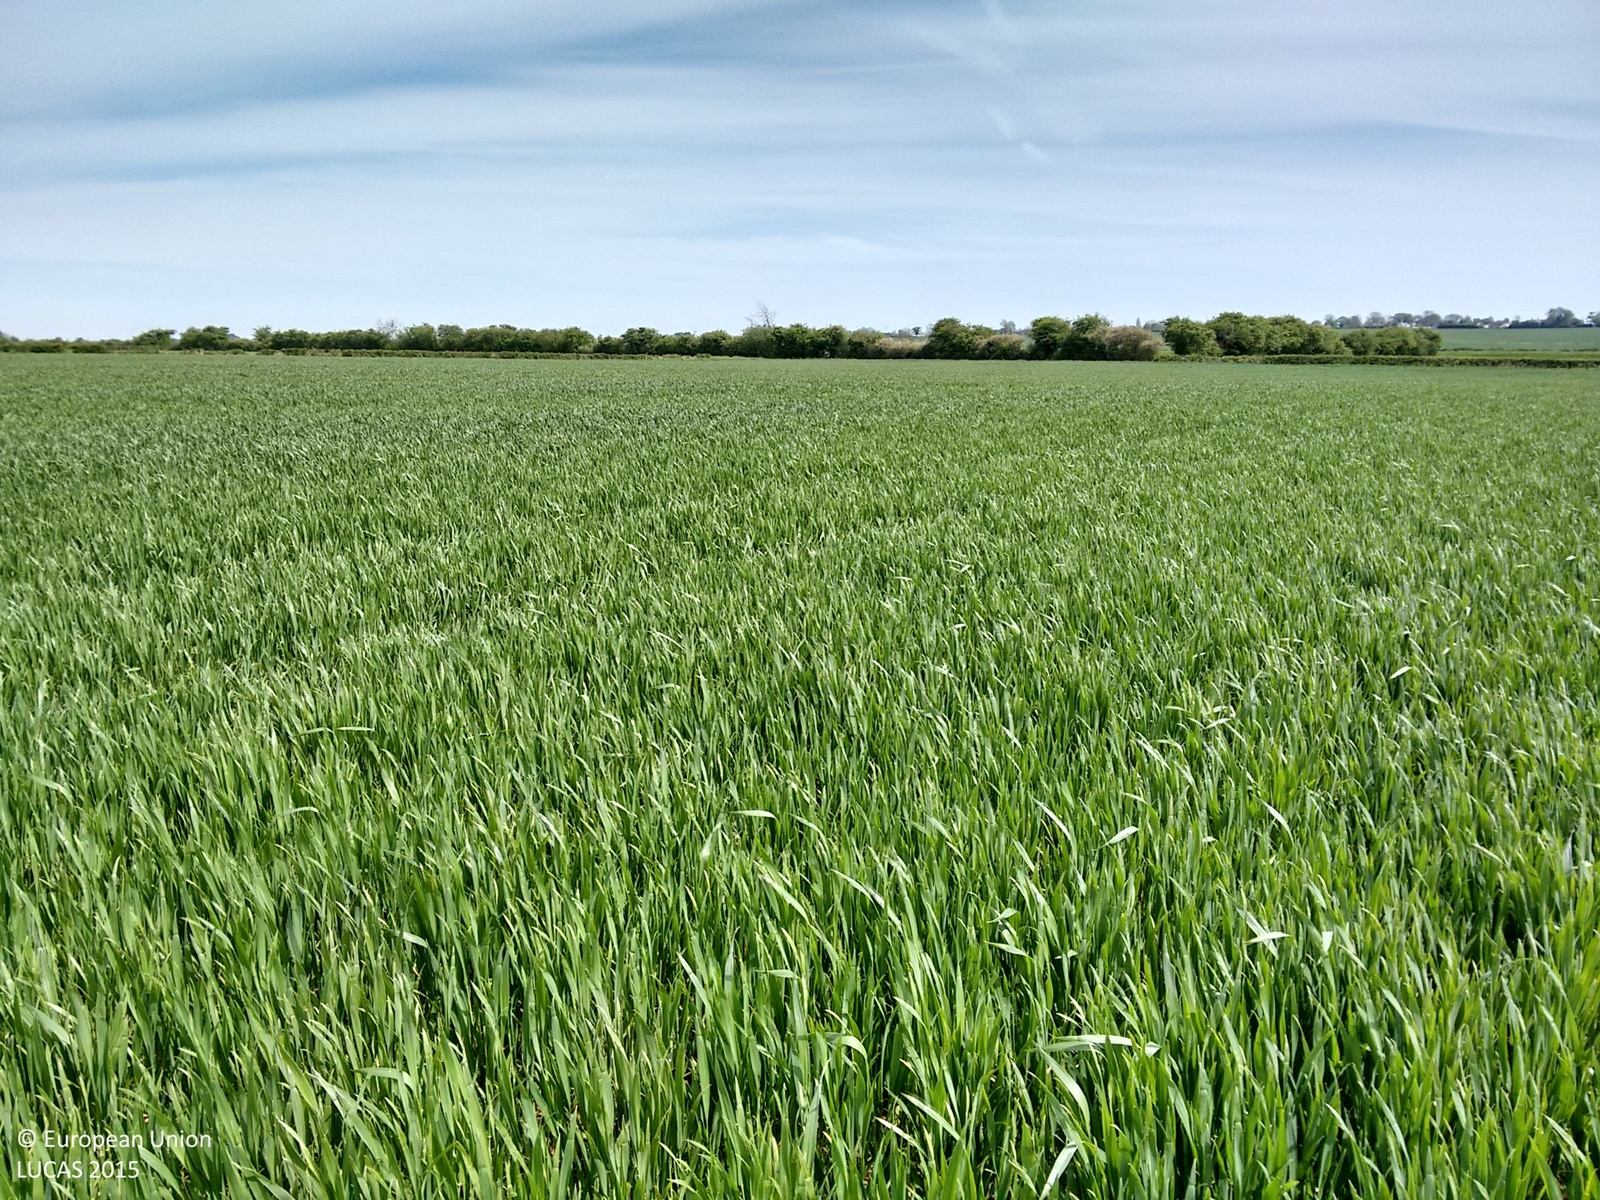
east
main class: Cropland
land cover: Common wheat
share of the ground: > 75 %
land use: Agriculture (excluding fallow land and kitchen gardens)
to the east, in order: Common wheat; Grass margins; Ditches and canals; Managed hedges; Fences; Grassland without tree/shrub cover
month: May
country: GB
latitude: 53.3244
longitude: 0.1357
